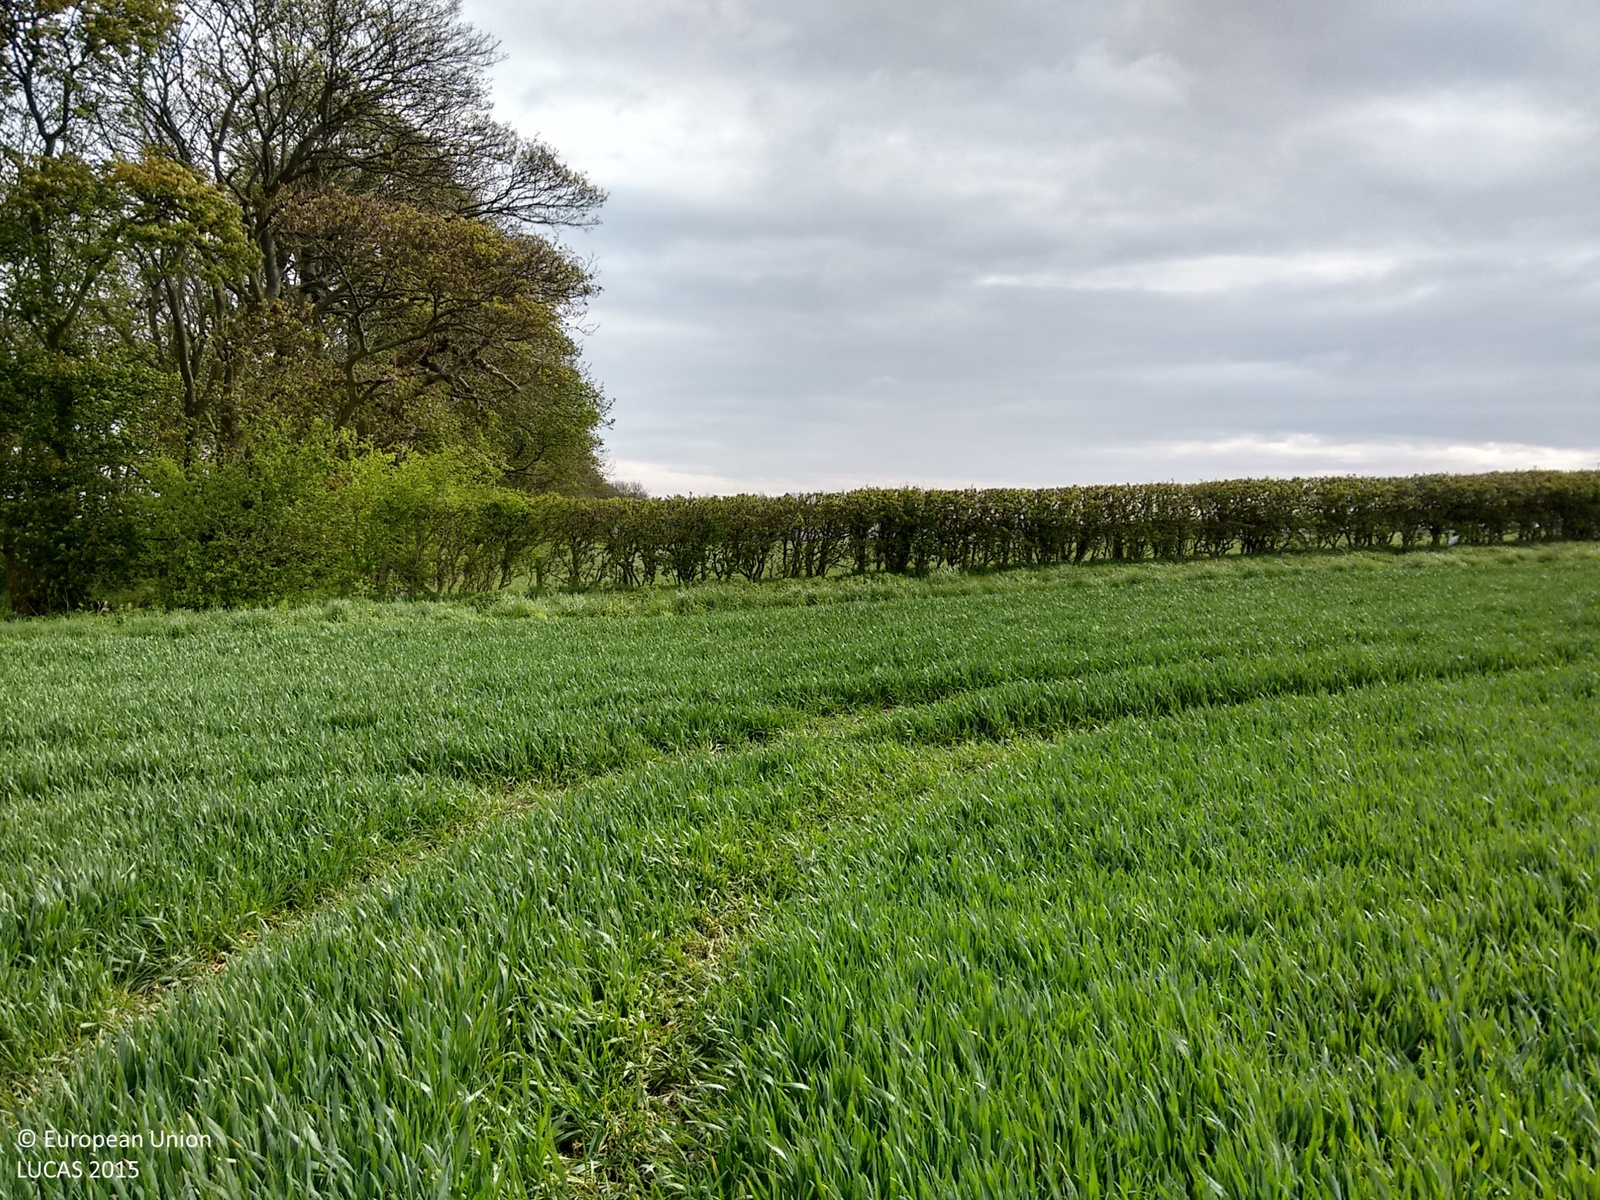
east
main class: Cropland
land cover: Common wheat
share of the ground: > 75 %
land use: Agriculture (excluding fallow land and kitchen gardens)
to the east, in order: Common wheat; Grass margins; Managed hedges; Grassland without tree/shrub cover; Fences; Managed hedges; Grass margins; Common wheat; Grassland without tree/shrub cover
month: May
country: GB
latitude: 54.1219
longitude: -0.3006
